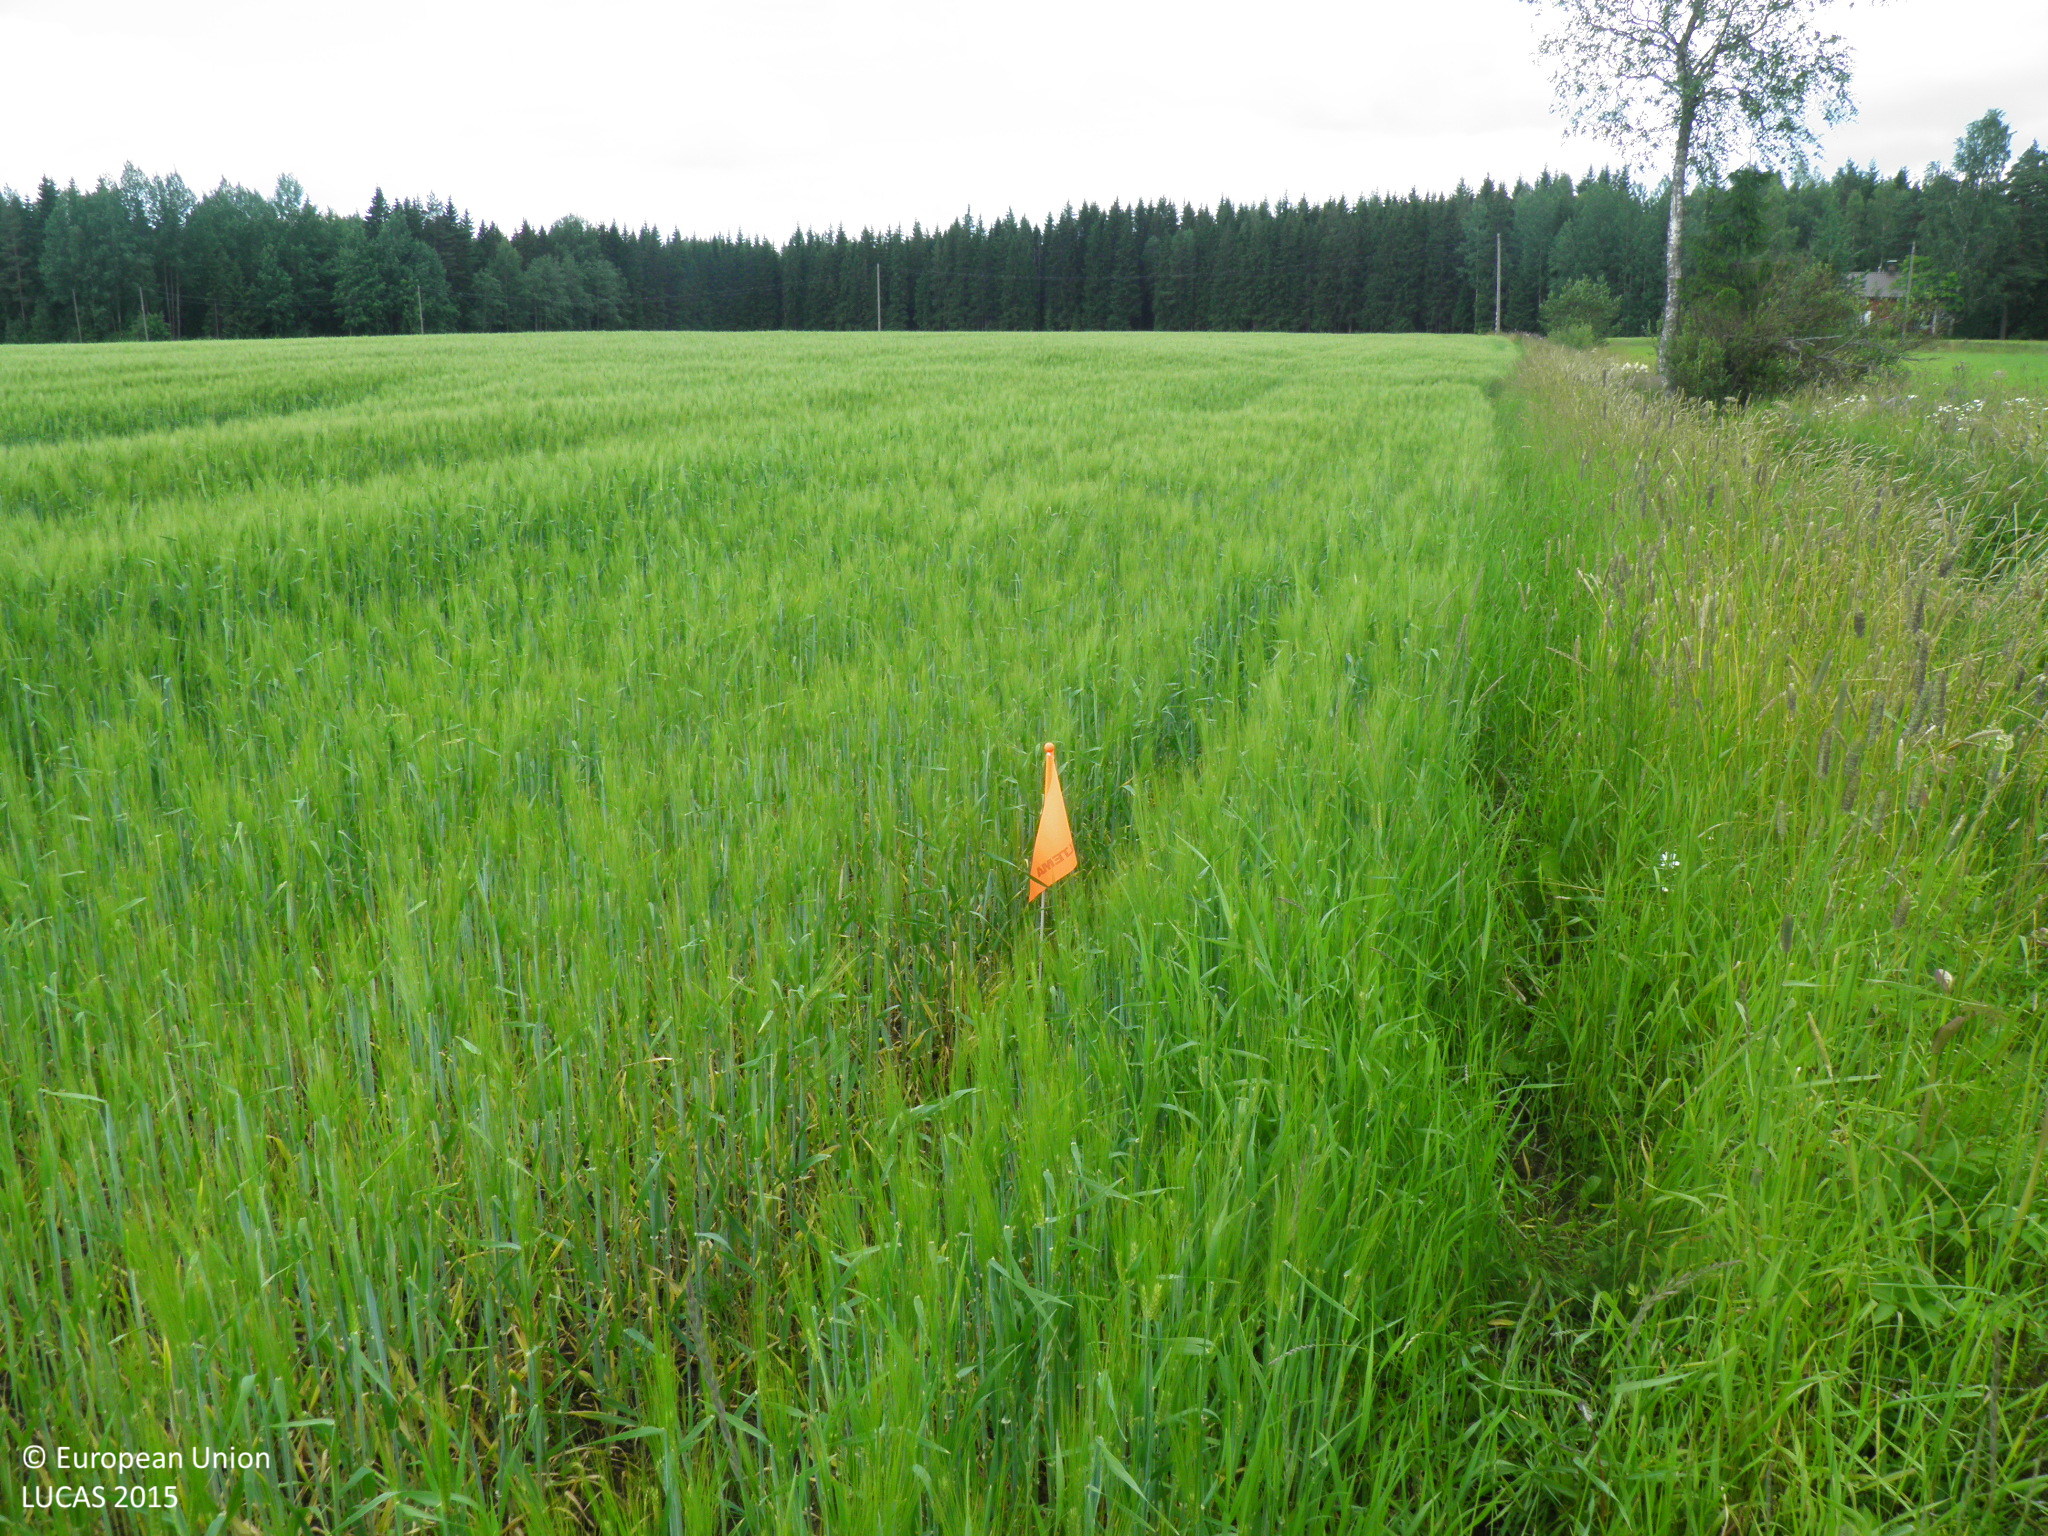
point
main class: Cropland
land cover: Barley
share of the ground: > 75 %
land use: Agriculture (excluding fallow land and kitchen gardens)
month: July
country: FI
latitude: 60.6553
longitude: 22.3787
